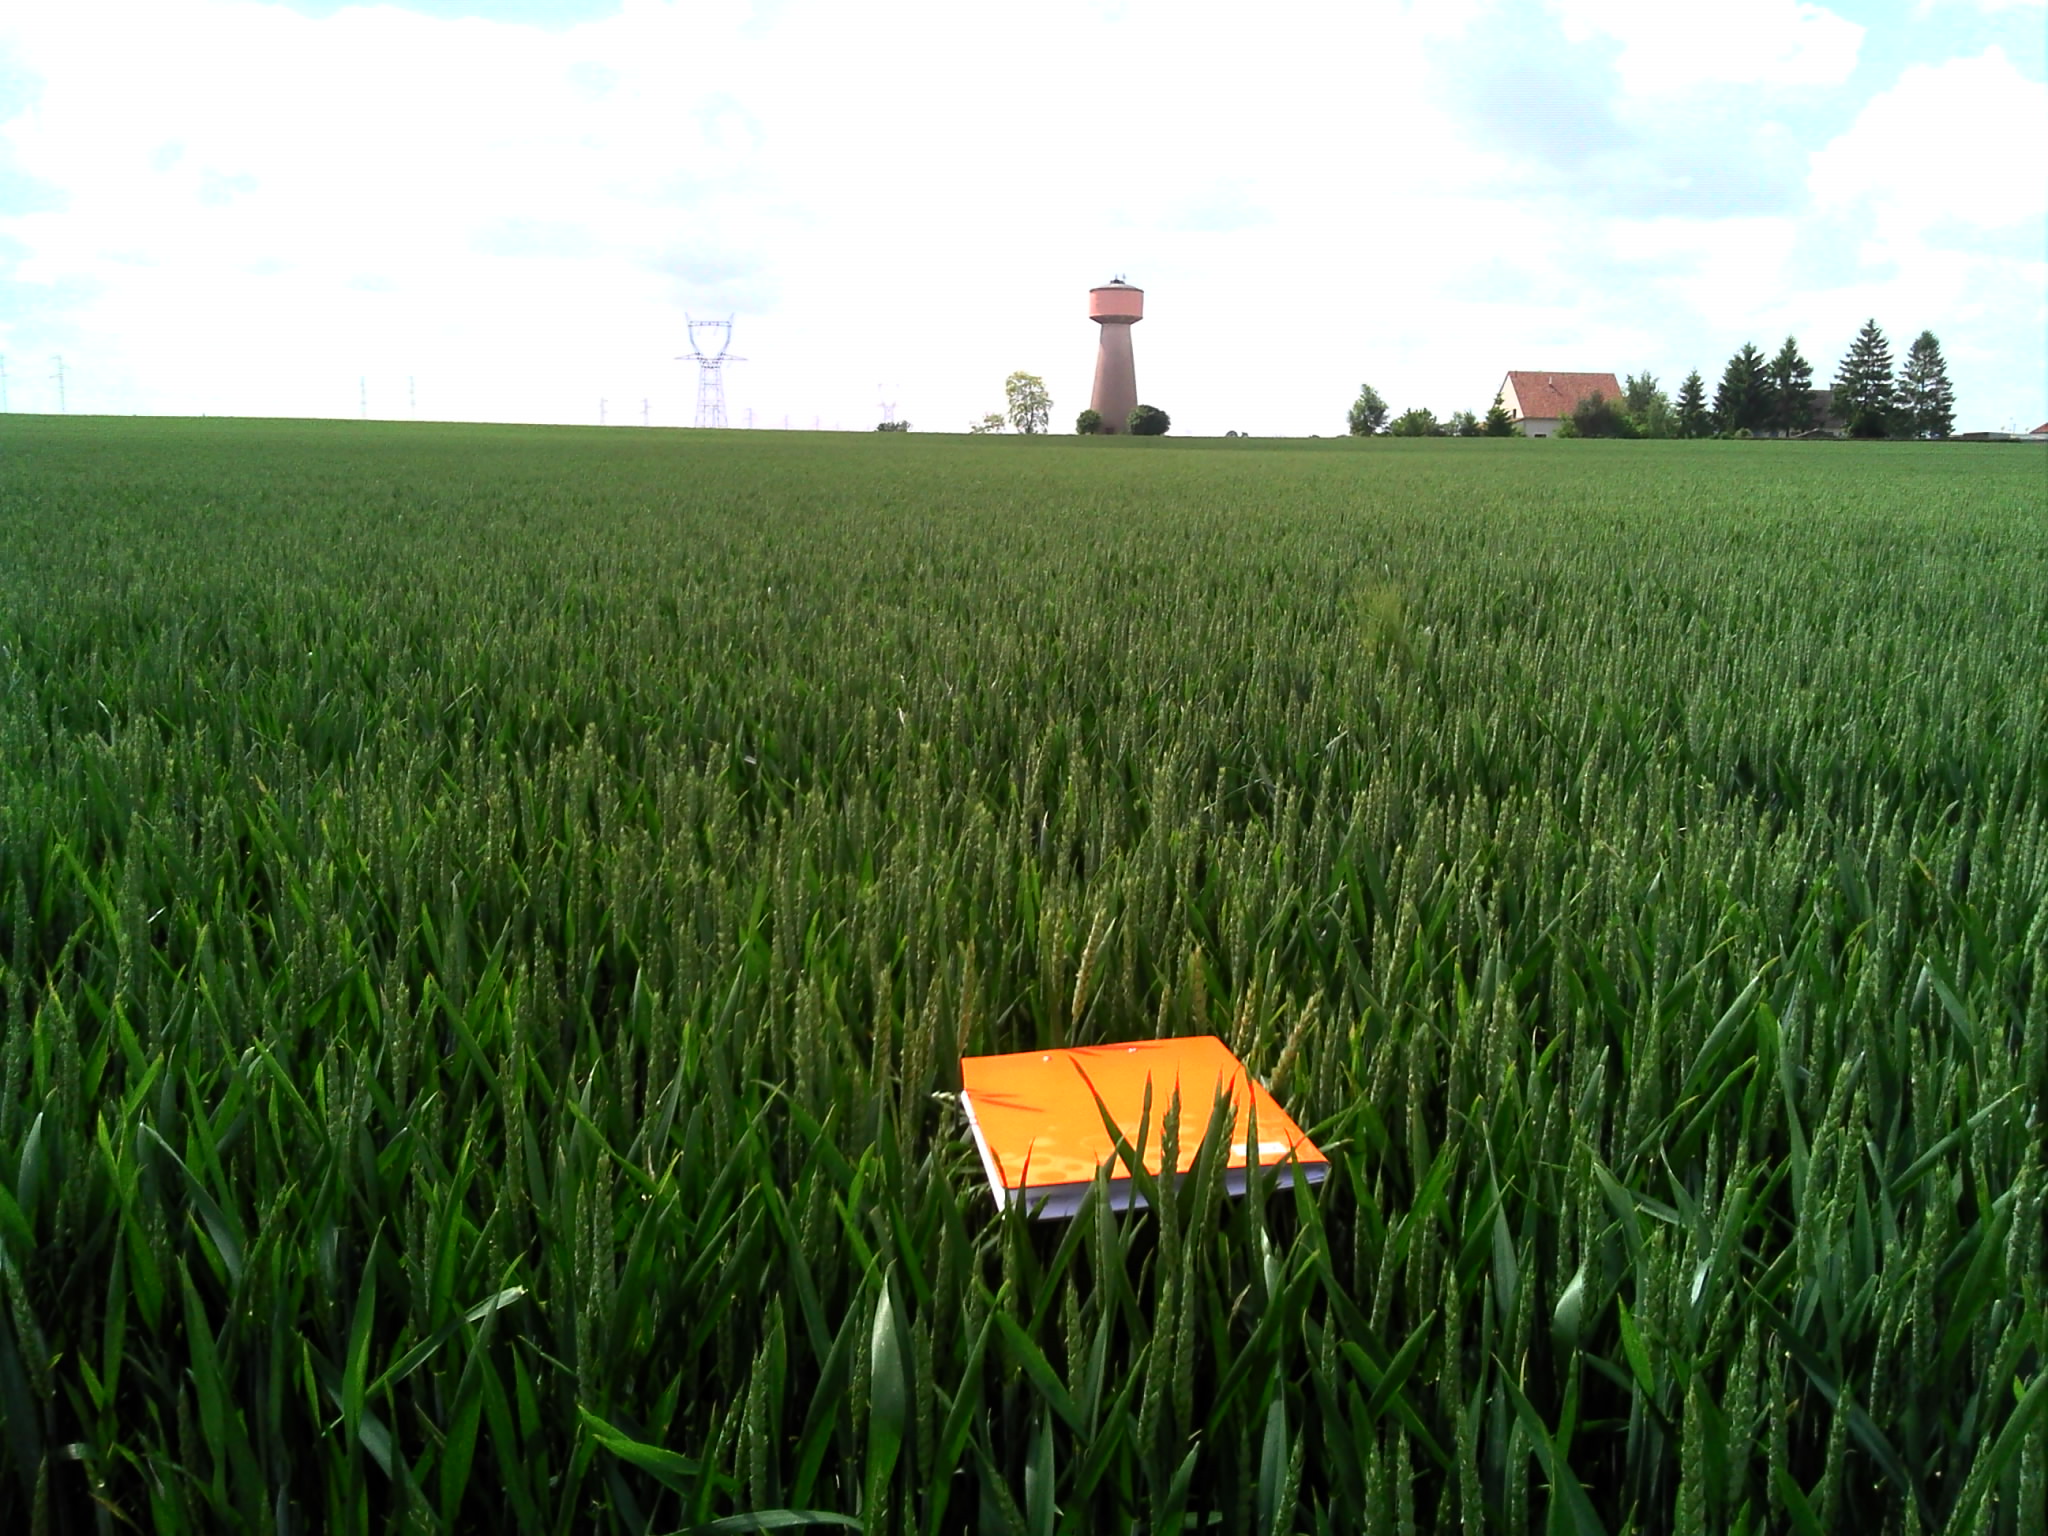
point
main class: Cropland
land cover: Common wheat
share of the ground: > 75 %
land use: Agriculture (excluding fallow land and kitchen gardens)
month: May
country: FR
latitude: 48.2342
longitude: 1.9220
